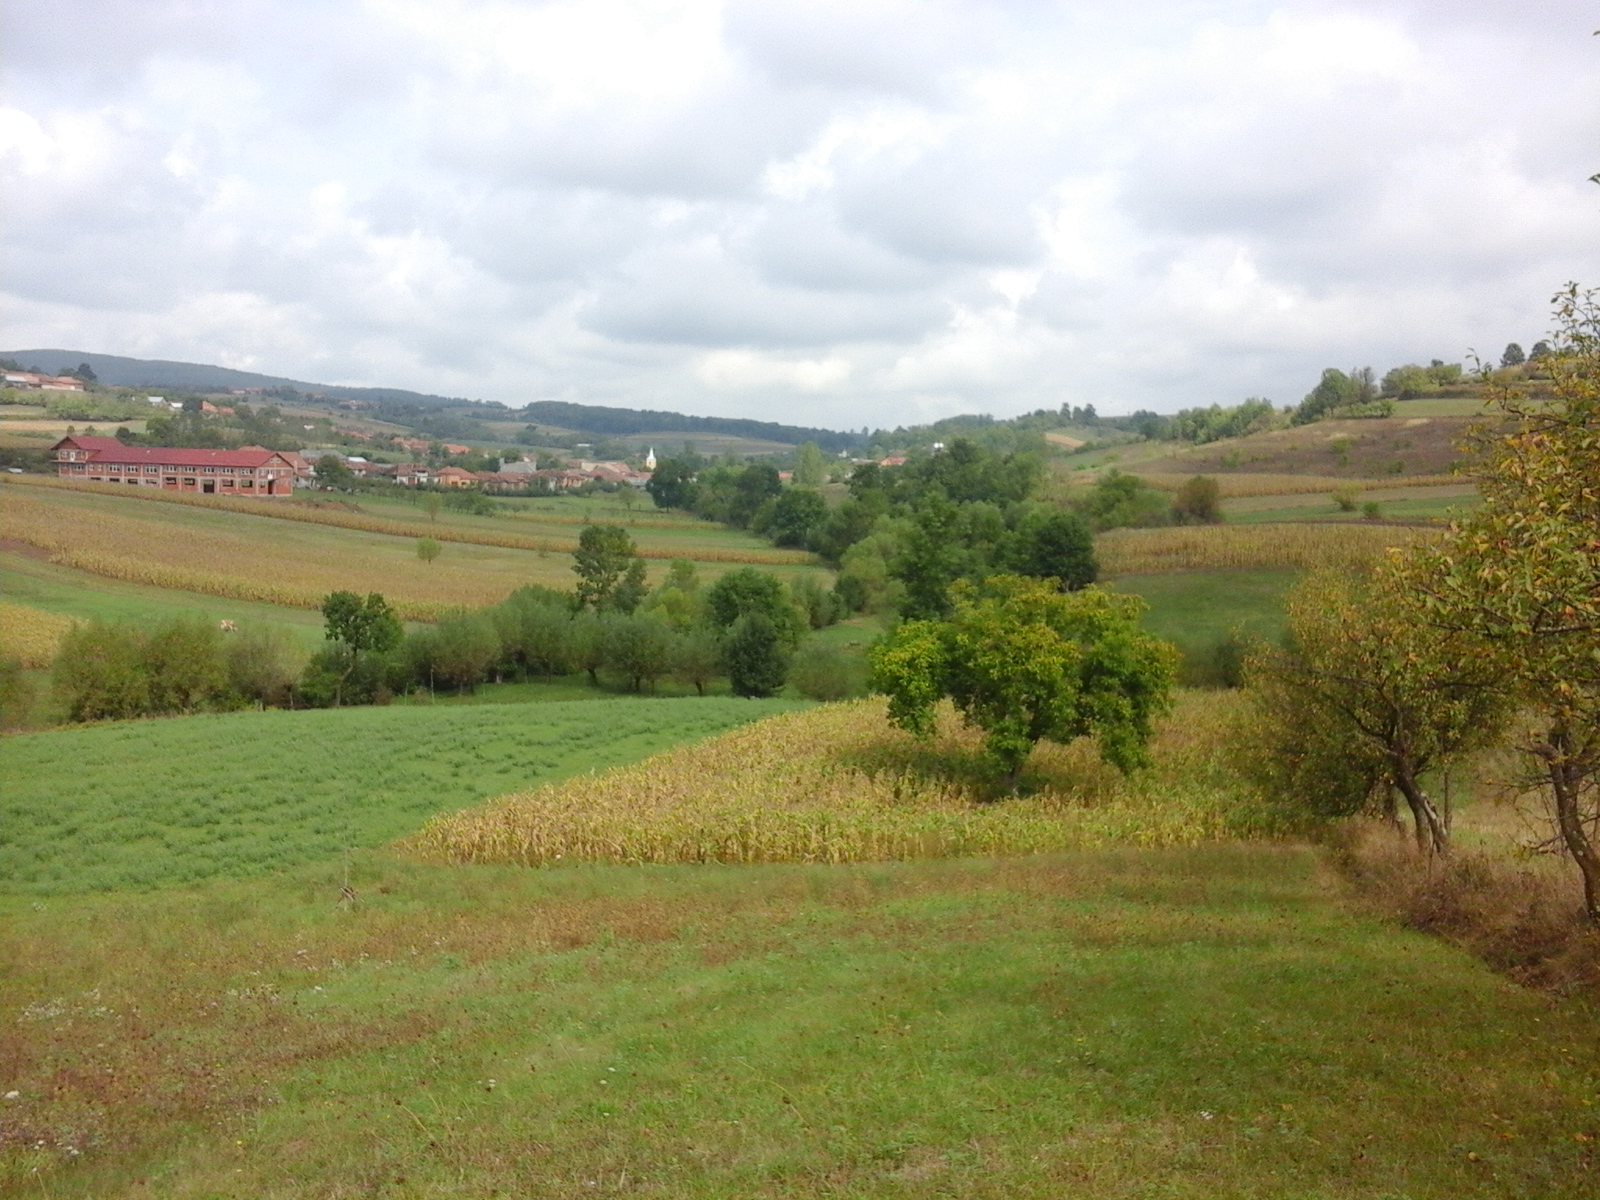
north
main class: Grassland
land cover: Grassland without tree/shrub cover
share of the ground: > 75 %
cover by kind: herbaceous plants 100 %
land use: Agriculture (excluding fallow land and kitchen gardens)
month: September
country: RO
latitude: 46.7029
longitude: 22.2251
